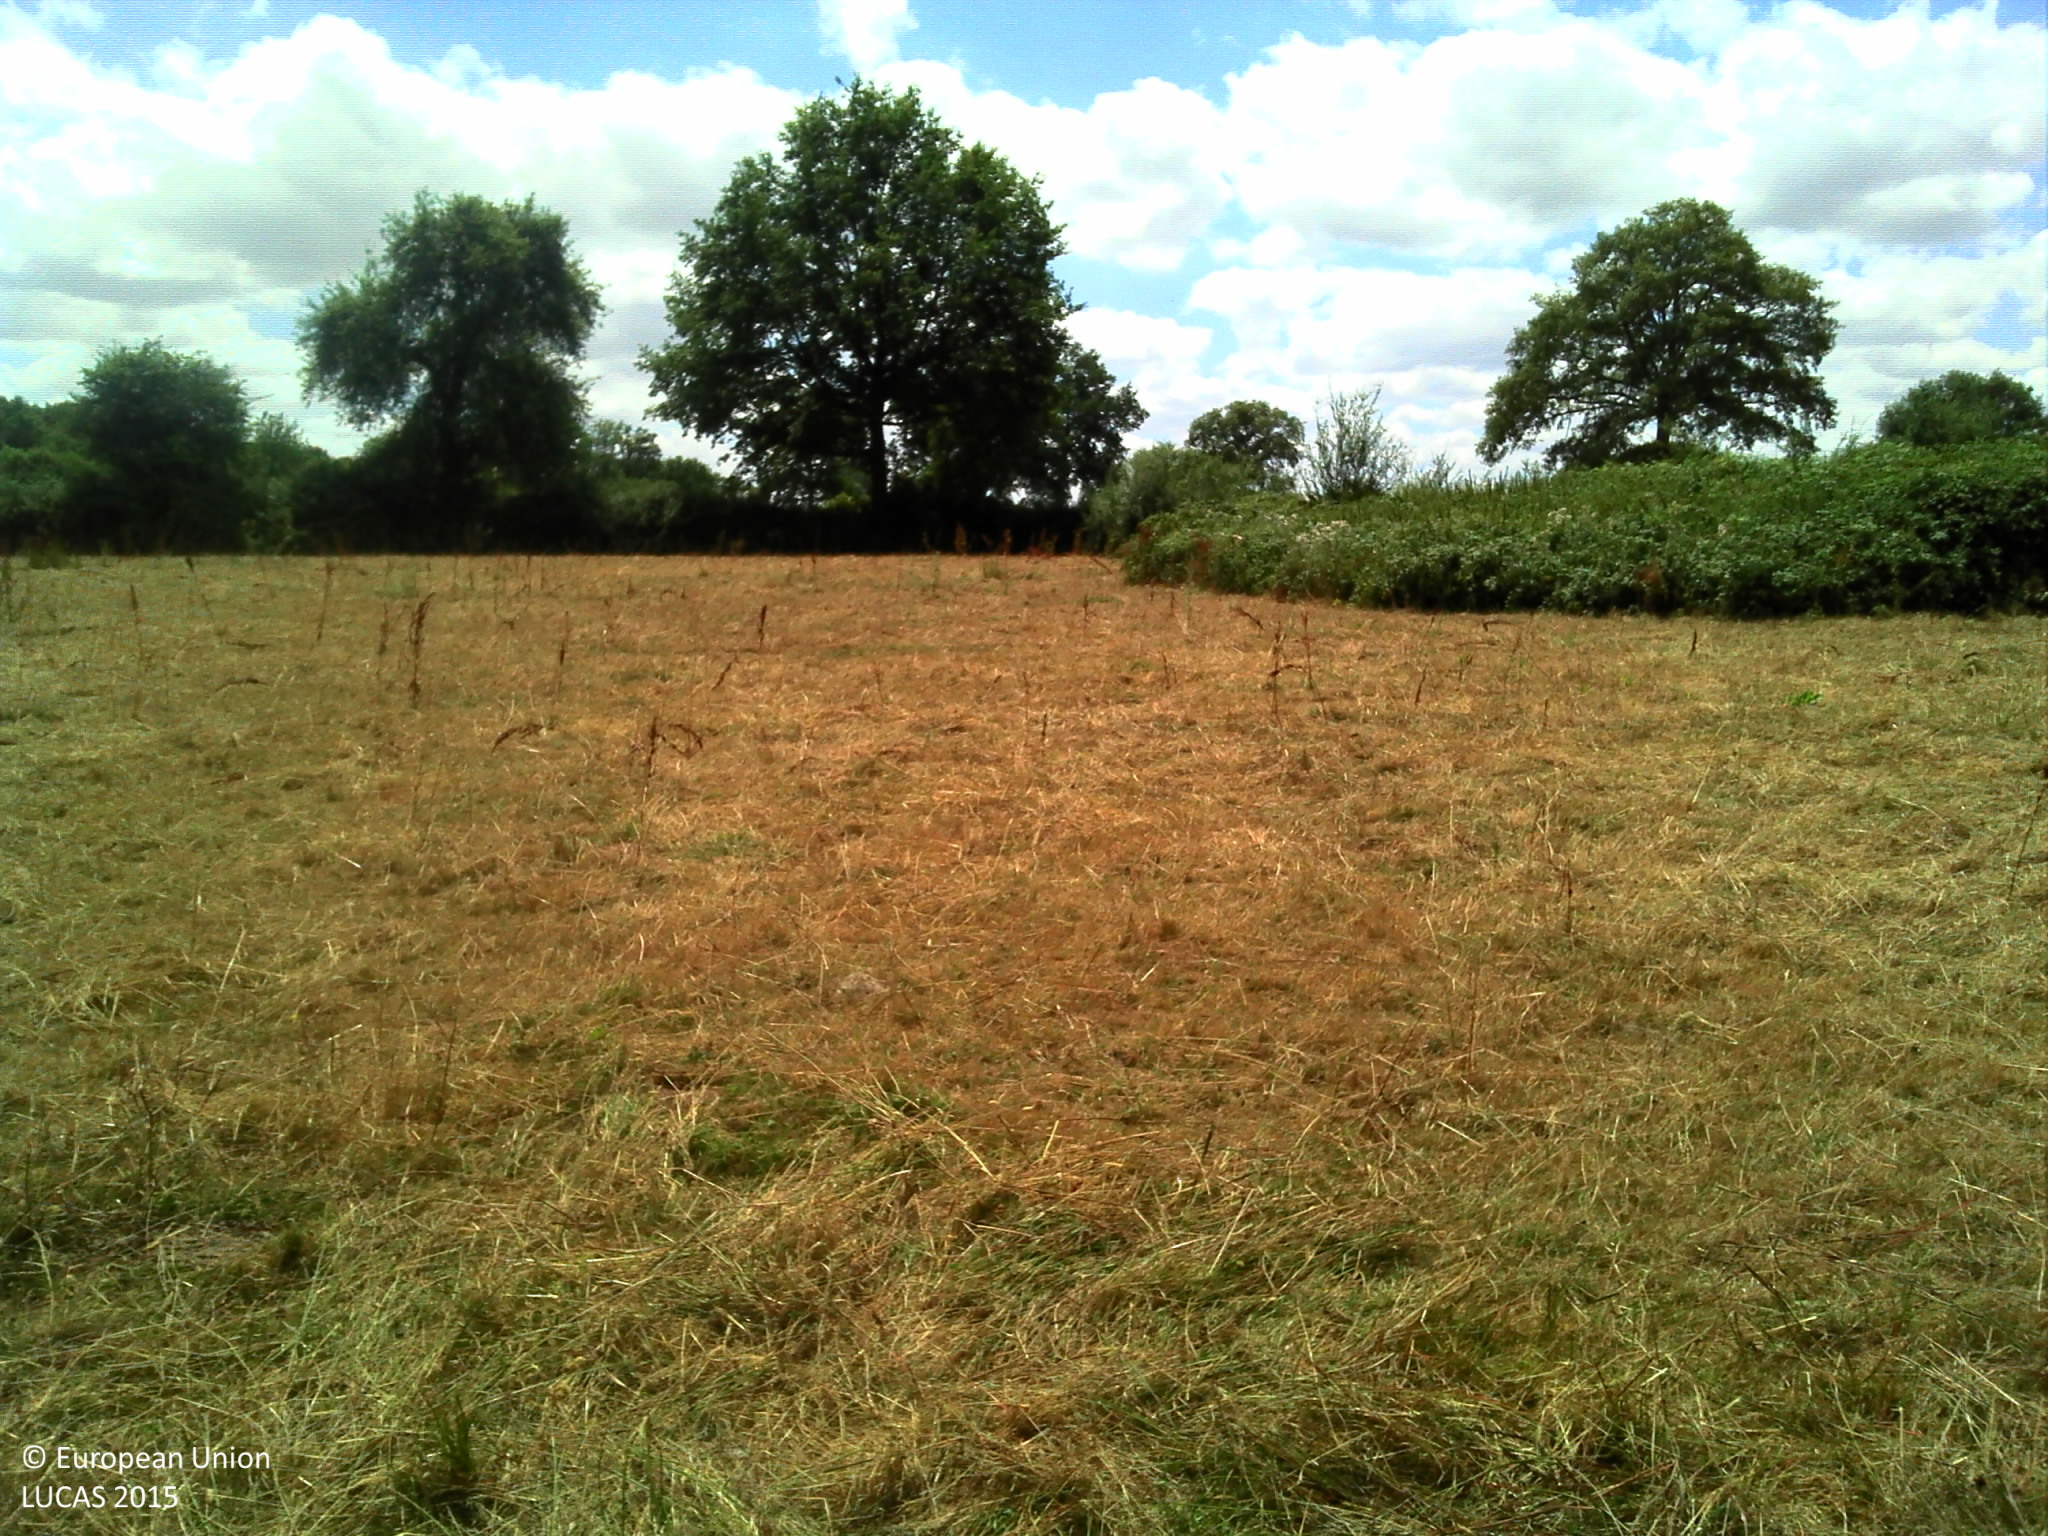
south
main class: Grassland
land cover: Grassland without tree/shrub cover
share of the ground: > 75 %
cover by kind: herbaceous plants 100 %
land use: Agriculture (excluding fallow land and kitchen gardens)
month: July
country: FR
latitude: 46.4834
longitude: 2.2171
